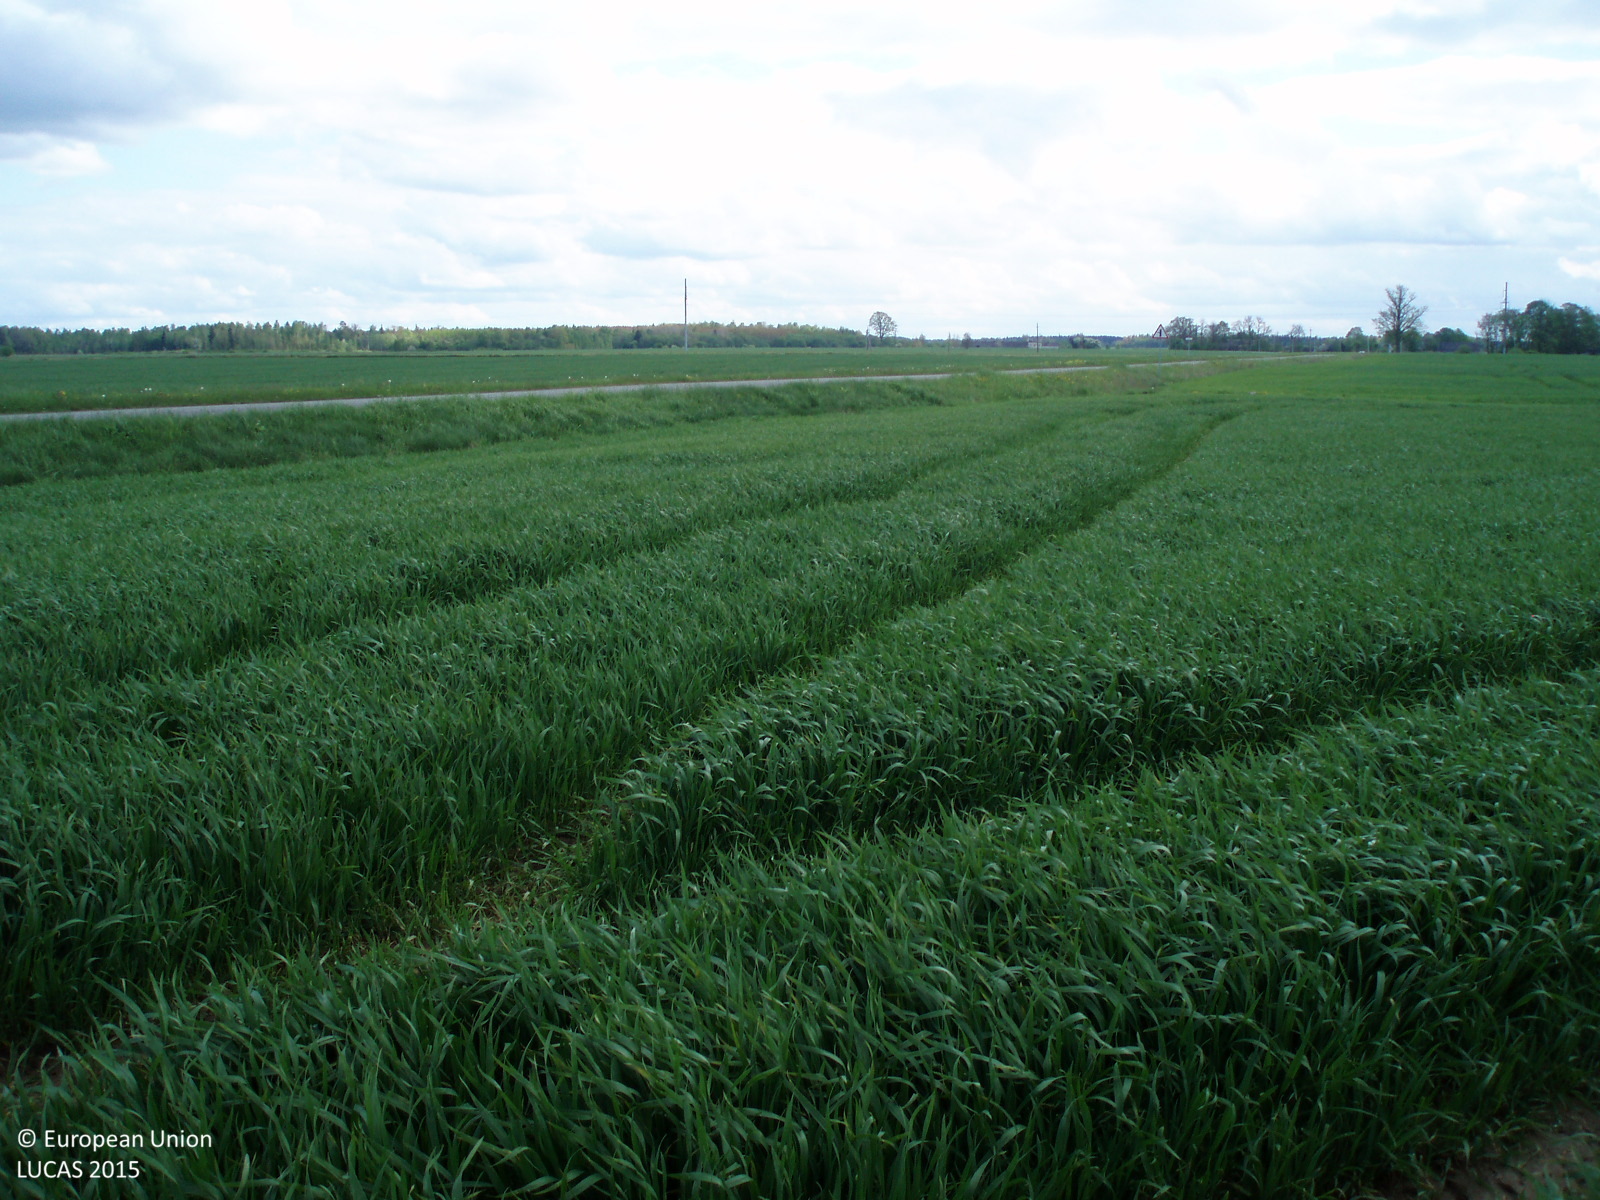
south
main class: Cropland
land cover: Common wheat
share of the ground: > 75 %
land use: Agriculture (excluding fallow land and kitchen gardens)
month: May
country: LT
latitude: 56.3421
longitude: 22.4659
